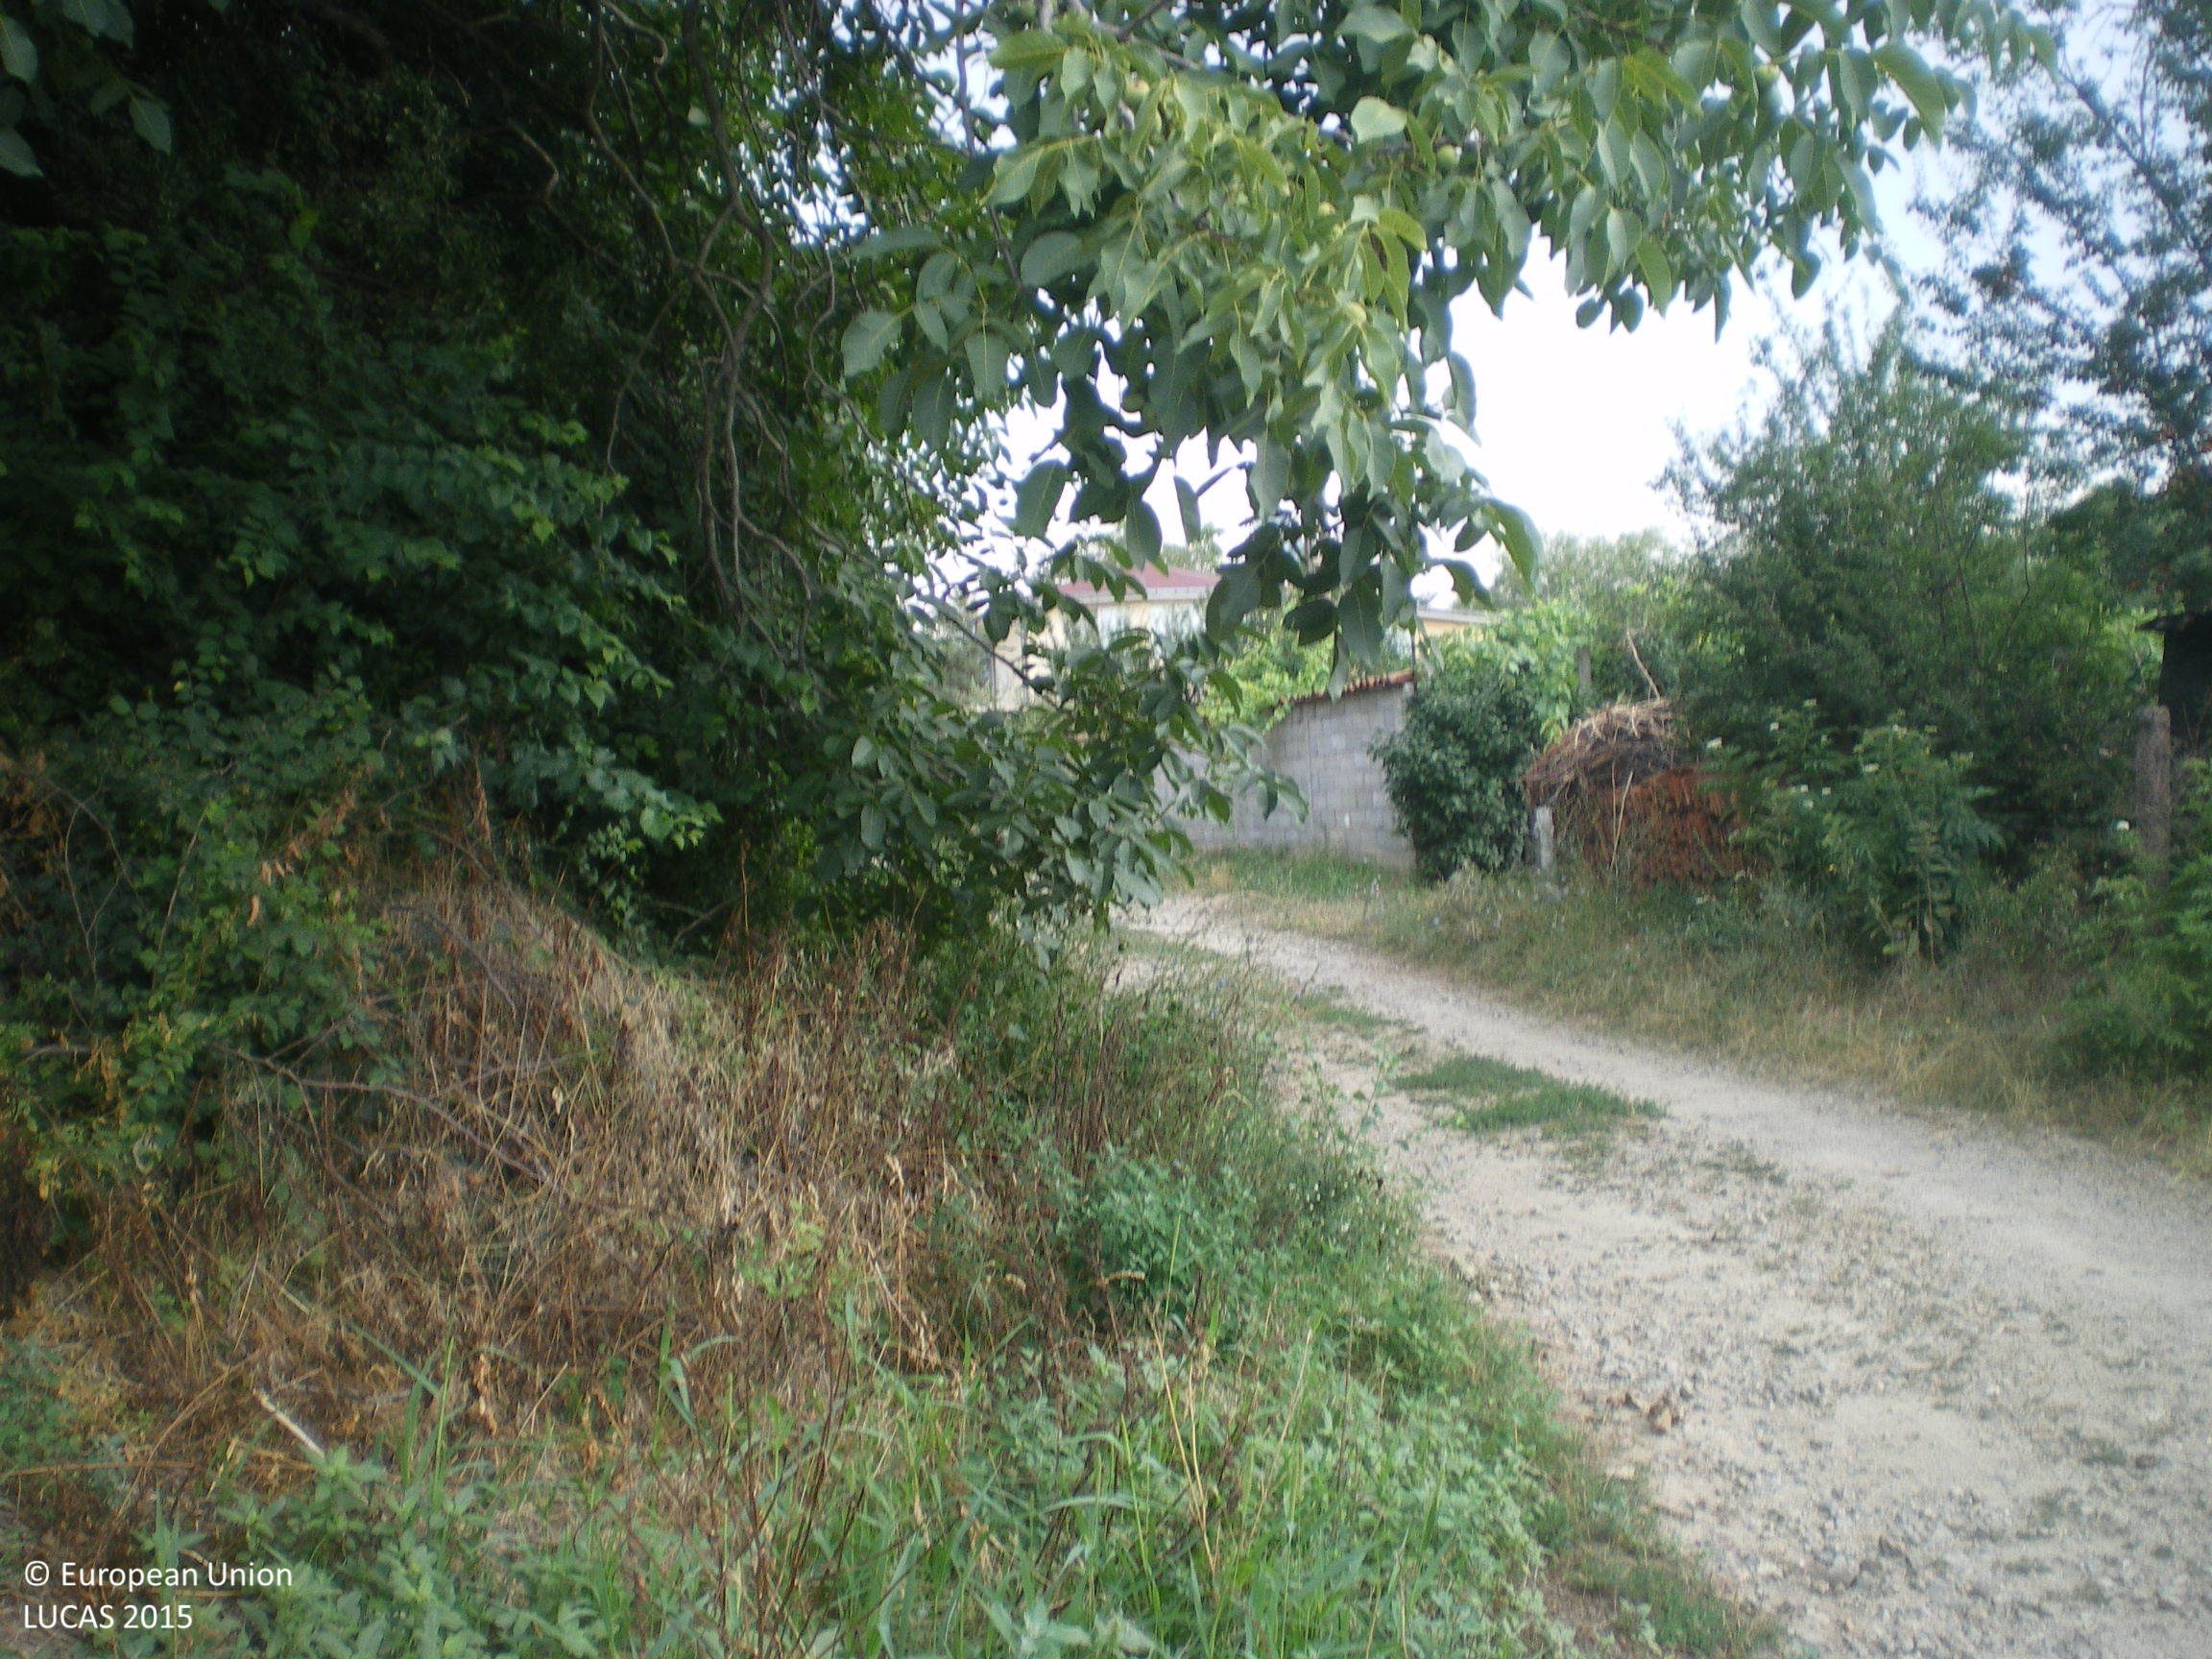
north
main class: Cropland
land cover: Apple fruit
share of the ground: 25 - 50 %
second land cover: Other bare soil
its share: > 75 %
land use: Kitchen garden
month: August
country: BG
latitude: 42.6145
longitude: 25.3434
